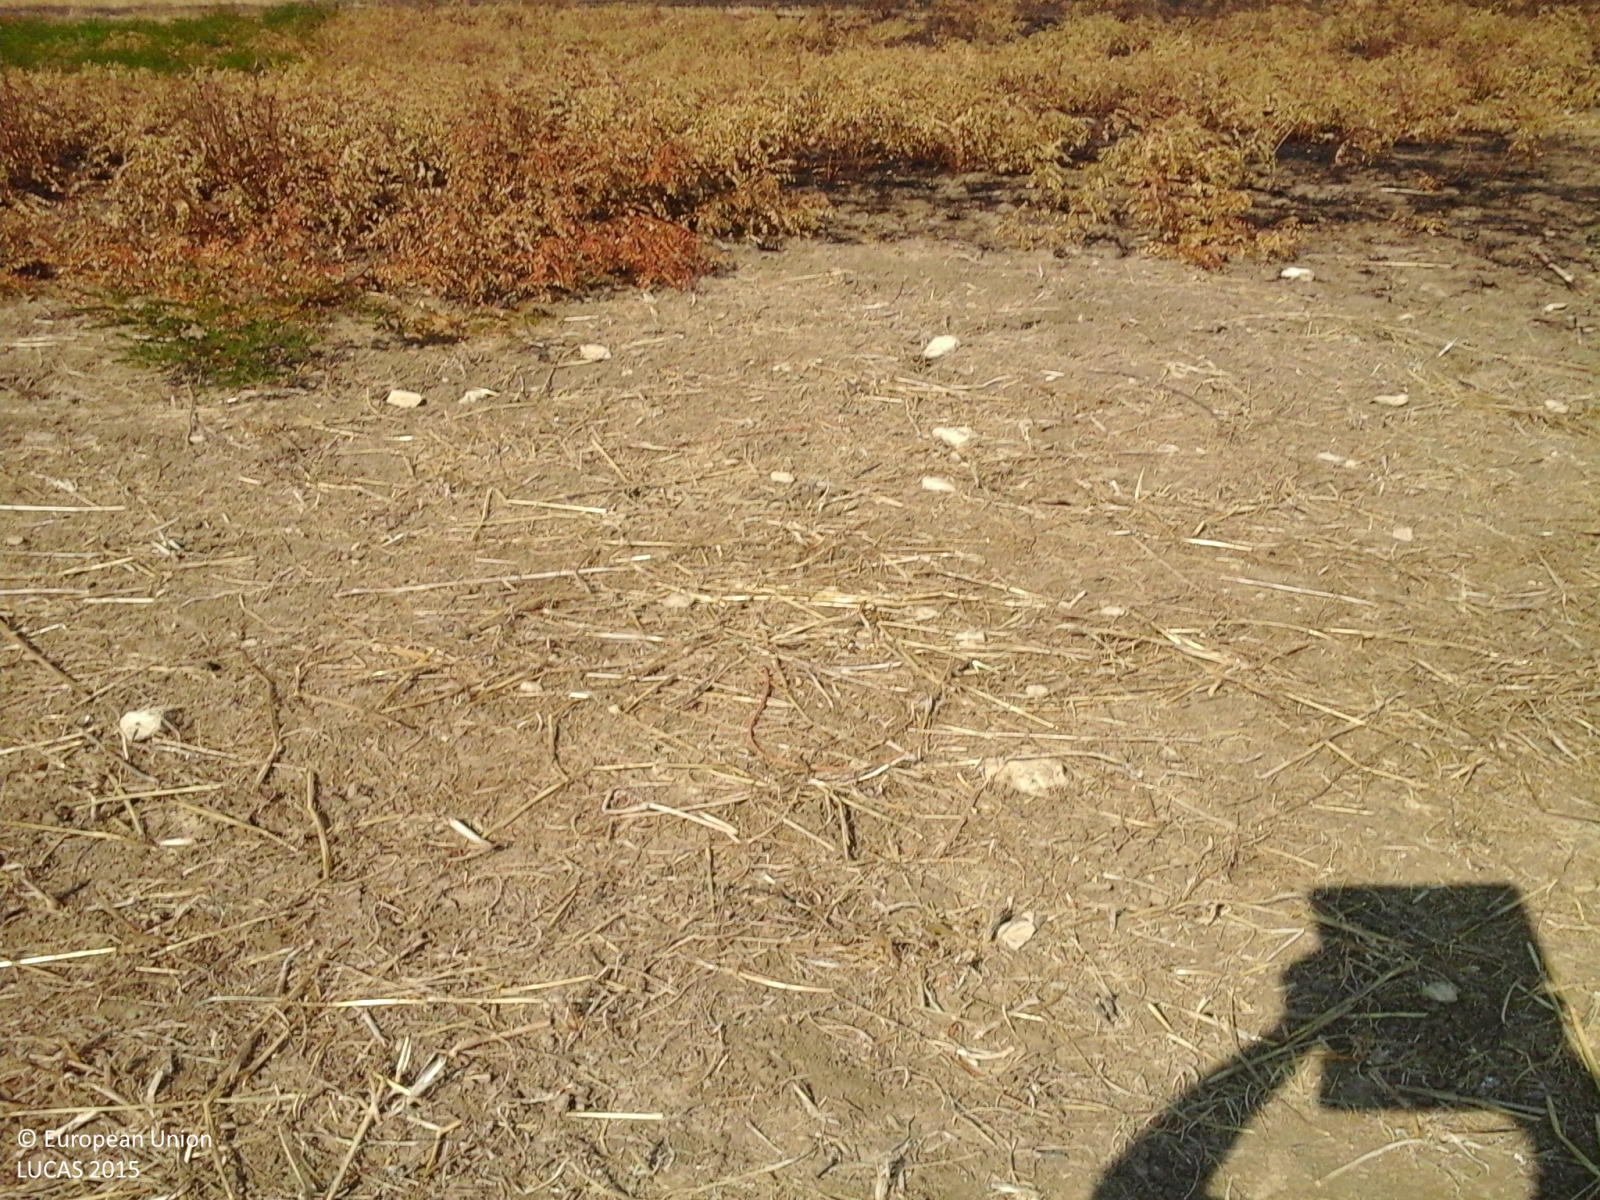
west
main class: Cropland
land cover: Durum wheat
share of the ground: > 75 %
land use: Agriculture (excluding fallow land and kitchen gardens)
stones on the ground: < 10 %
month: July
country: IT
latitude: 37.3143
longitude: 14.0872
